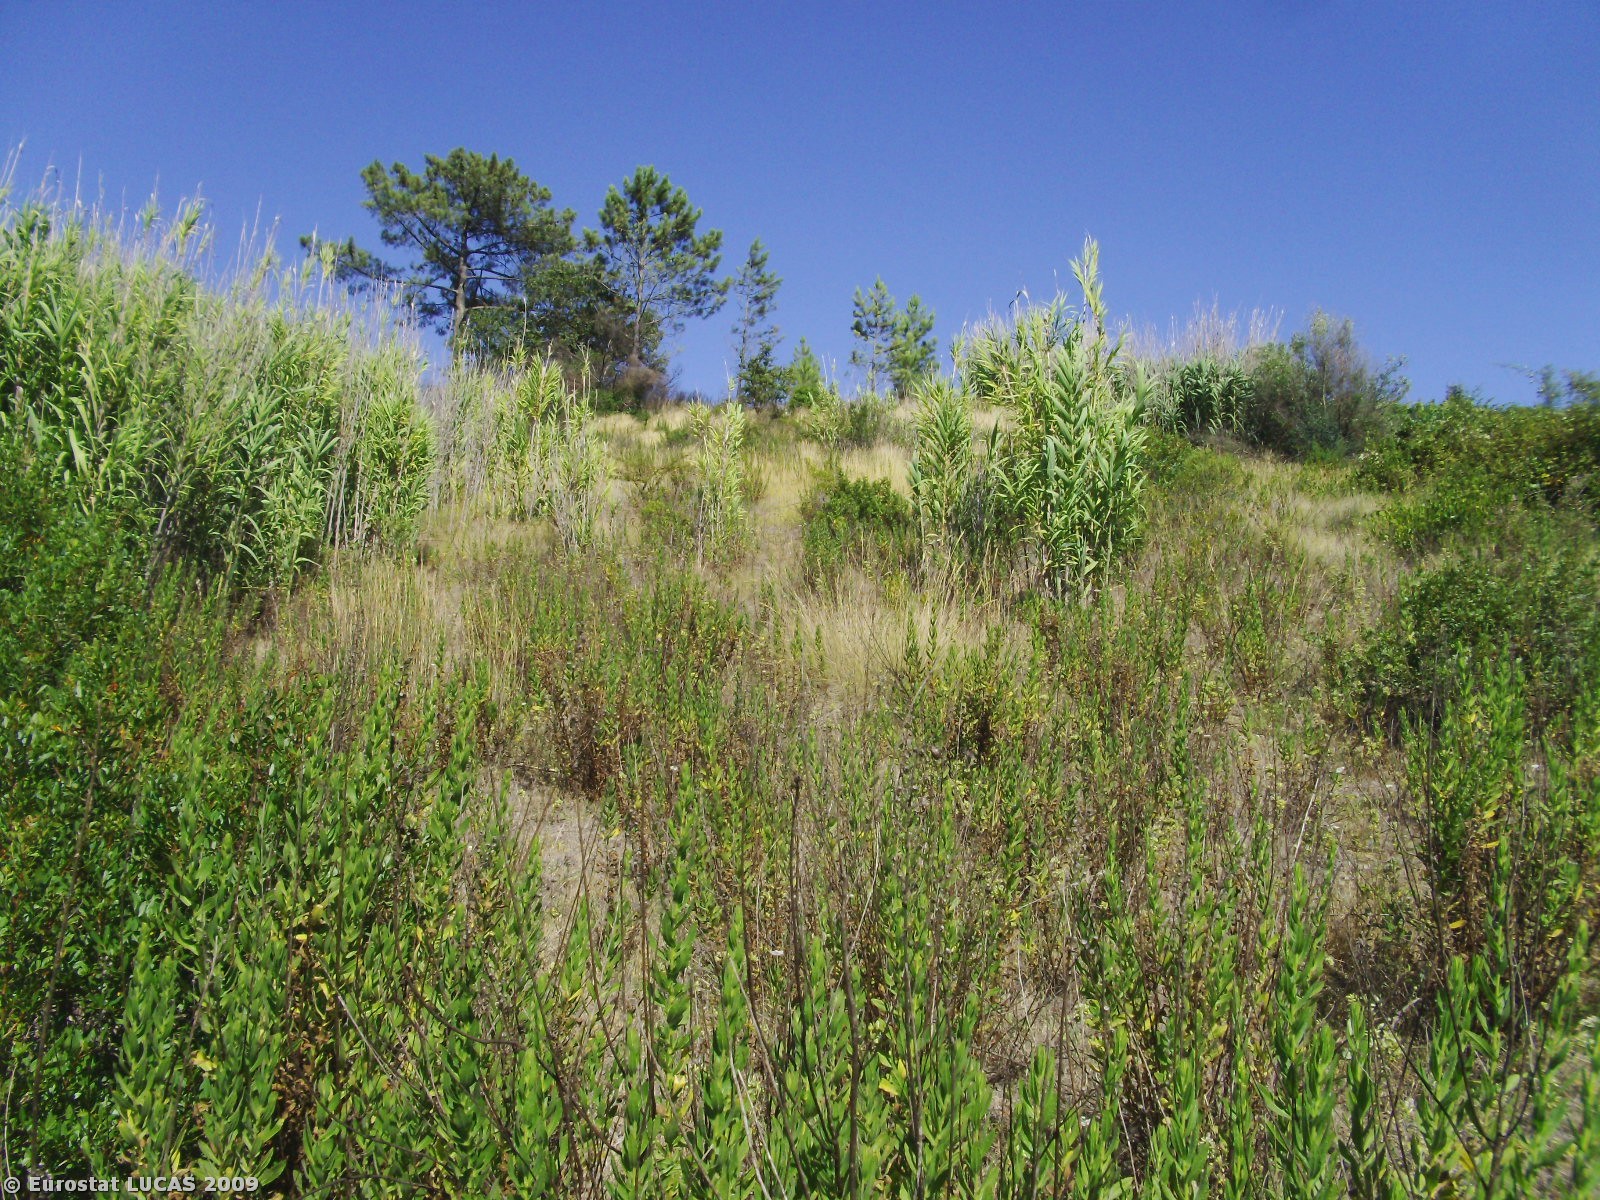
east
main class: Shrubland
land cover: Shrubland without tree cover
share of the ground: > 75 %
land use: Unused
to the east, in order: Shrubland without tree cover; Spontaneously vegetated surfaces; Shrubland with sparse tree cover; Spontaneously vegetated surfaces; Shrubland without tree cover; Tracks; Shrubland with sparse tree cover
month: July
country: PT
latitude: 39.1998
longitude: -8.8465
